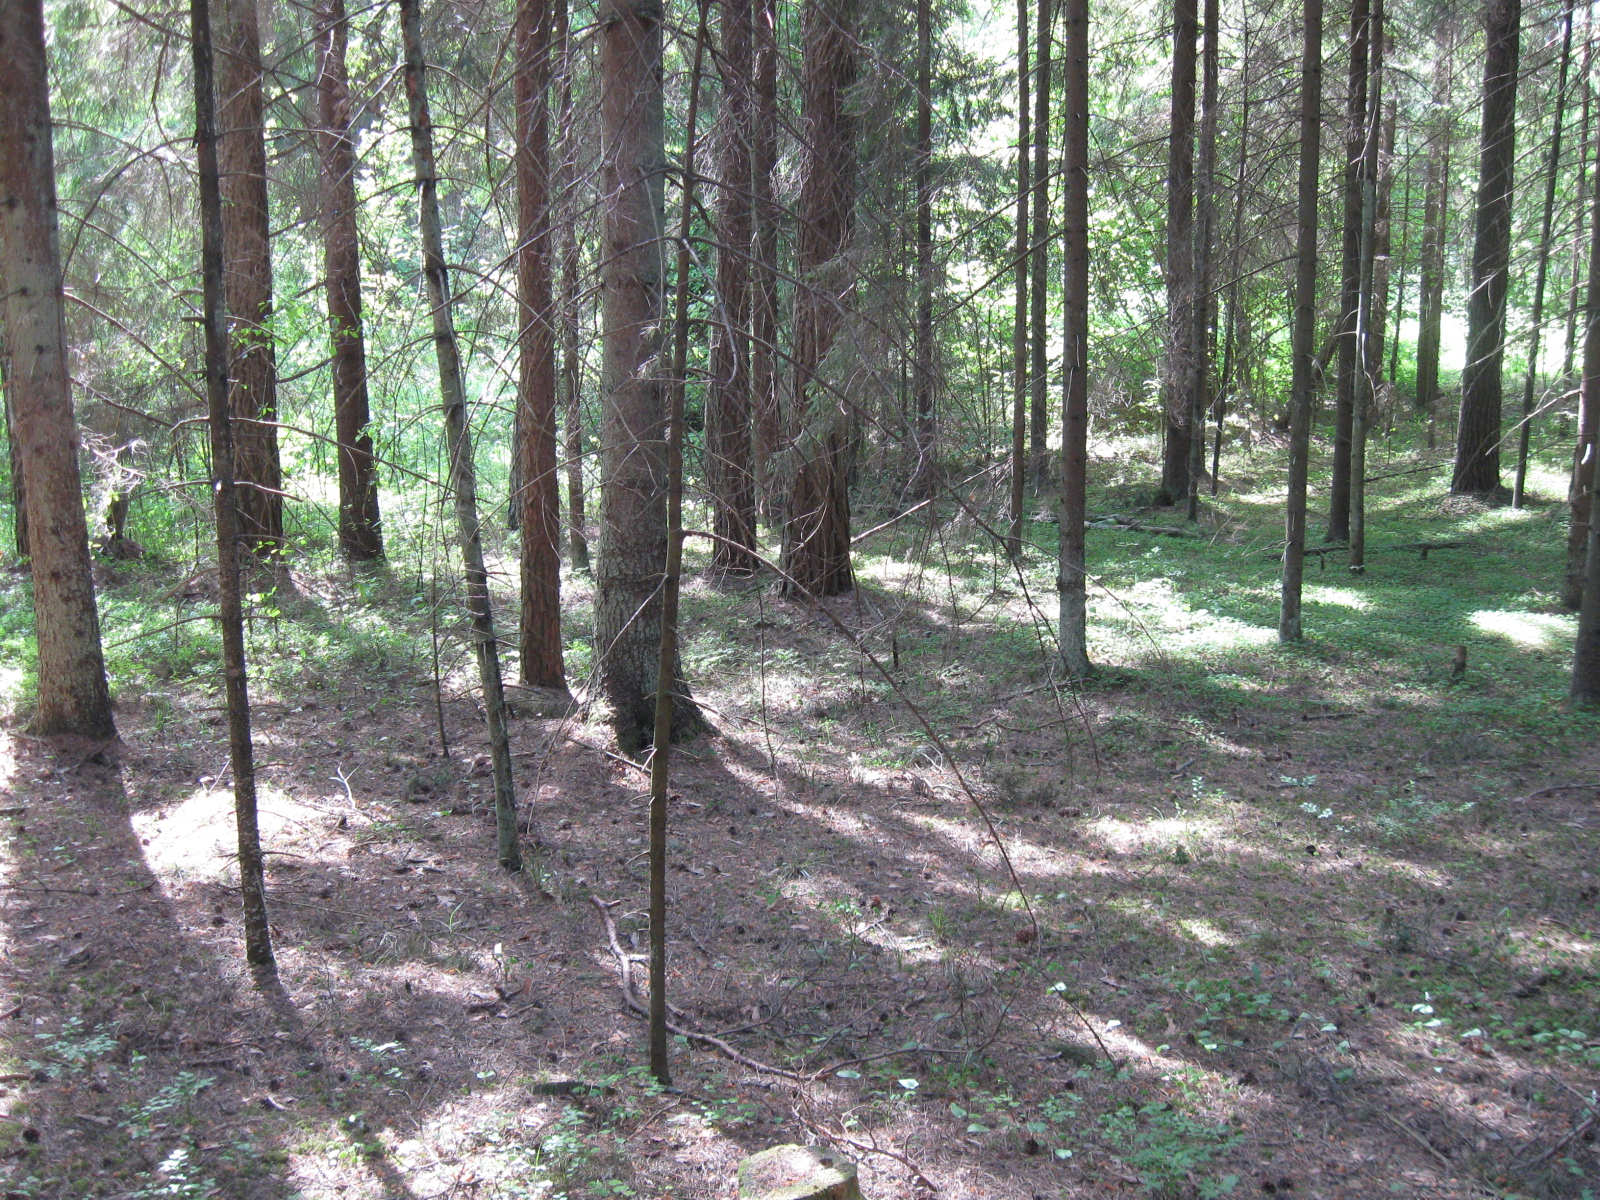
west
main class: Woodland
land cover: Other coniferous woodland
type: hemiboreal forest and nemoral coniferous forest and mixed broadleaved-coniferous forest
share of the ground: > 75 %
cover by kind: coniferous forest trees 100 %
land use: Forestry
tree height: > 5 m
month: June
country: LT
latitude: 54.6199
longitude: 23.9198
